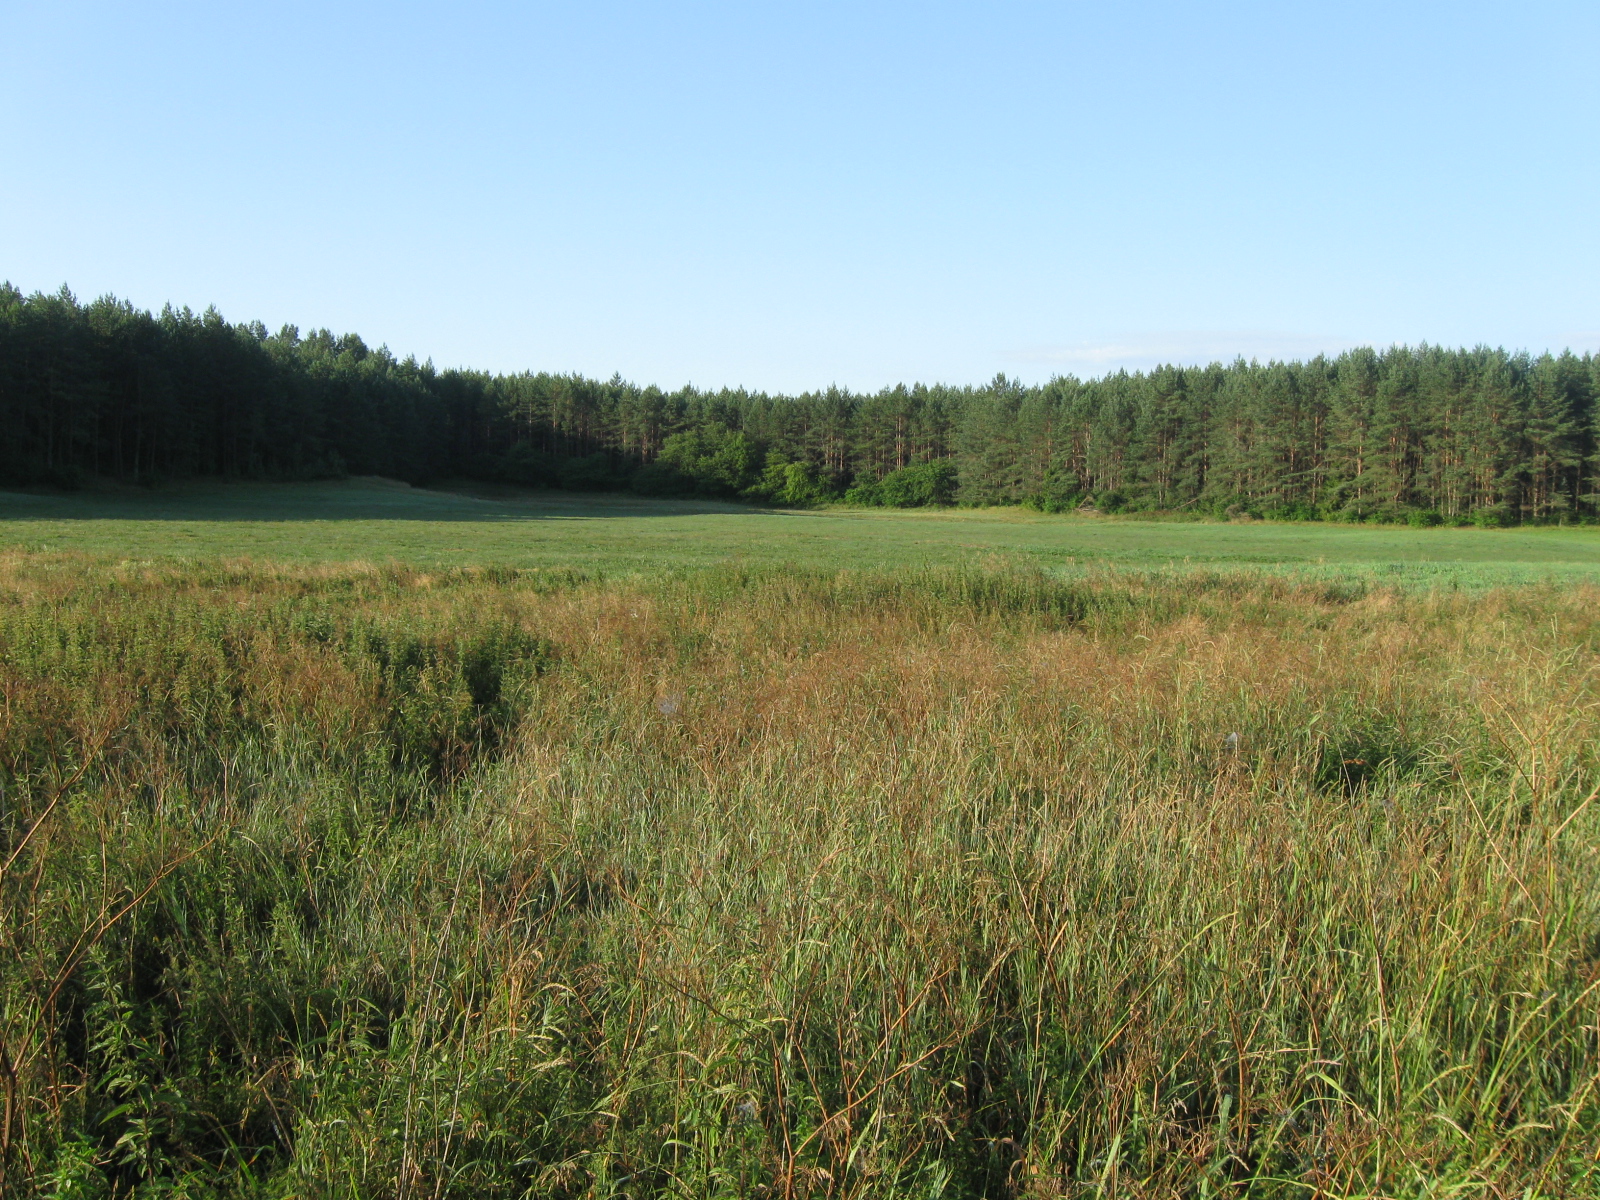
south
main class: Grassland
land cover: Grassland without tree/shrub cover
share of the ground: > 75 %
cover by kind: herbaceous plants 100 %
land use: Agriculture (excluding fallow land and kitchen gardens)
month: July
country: LT
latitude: 54.1382
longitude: 23.8189
